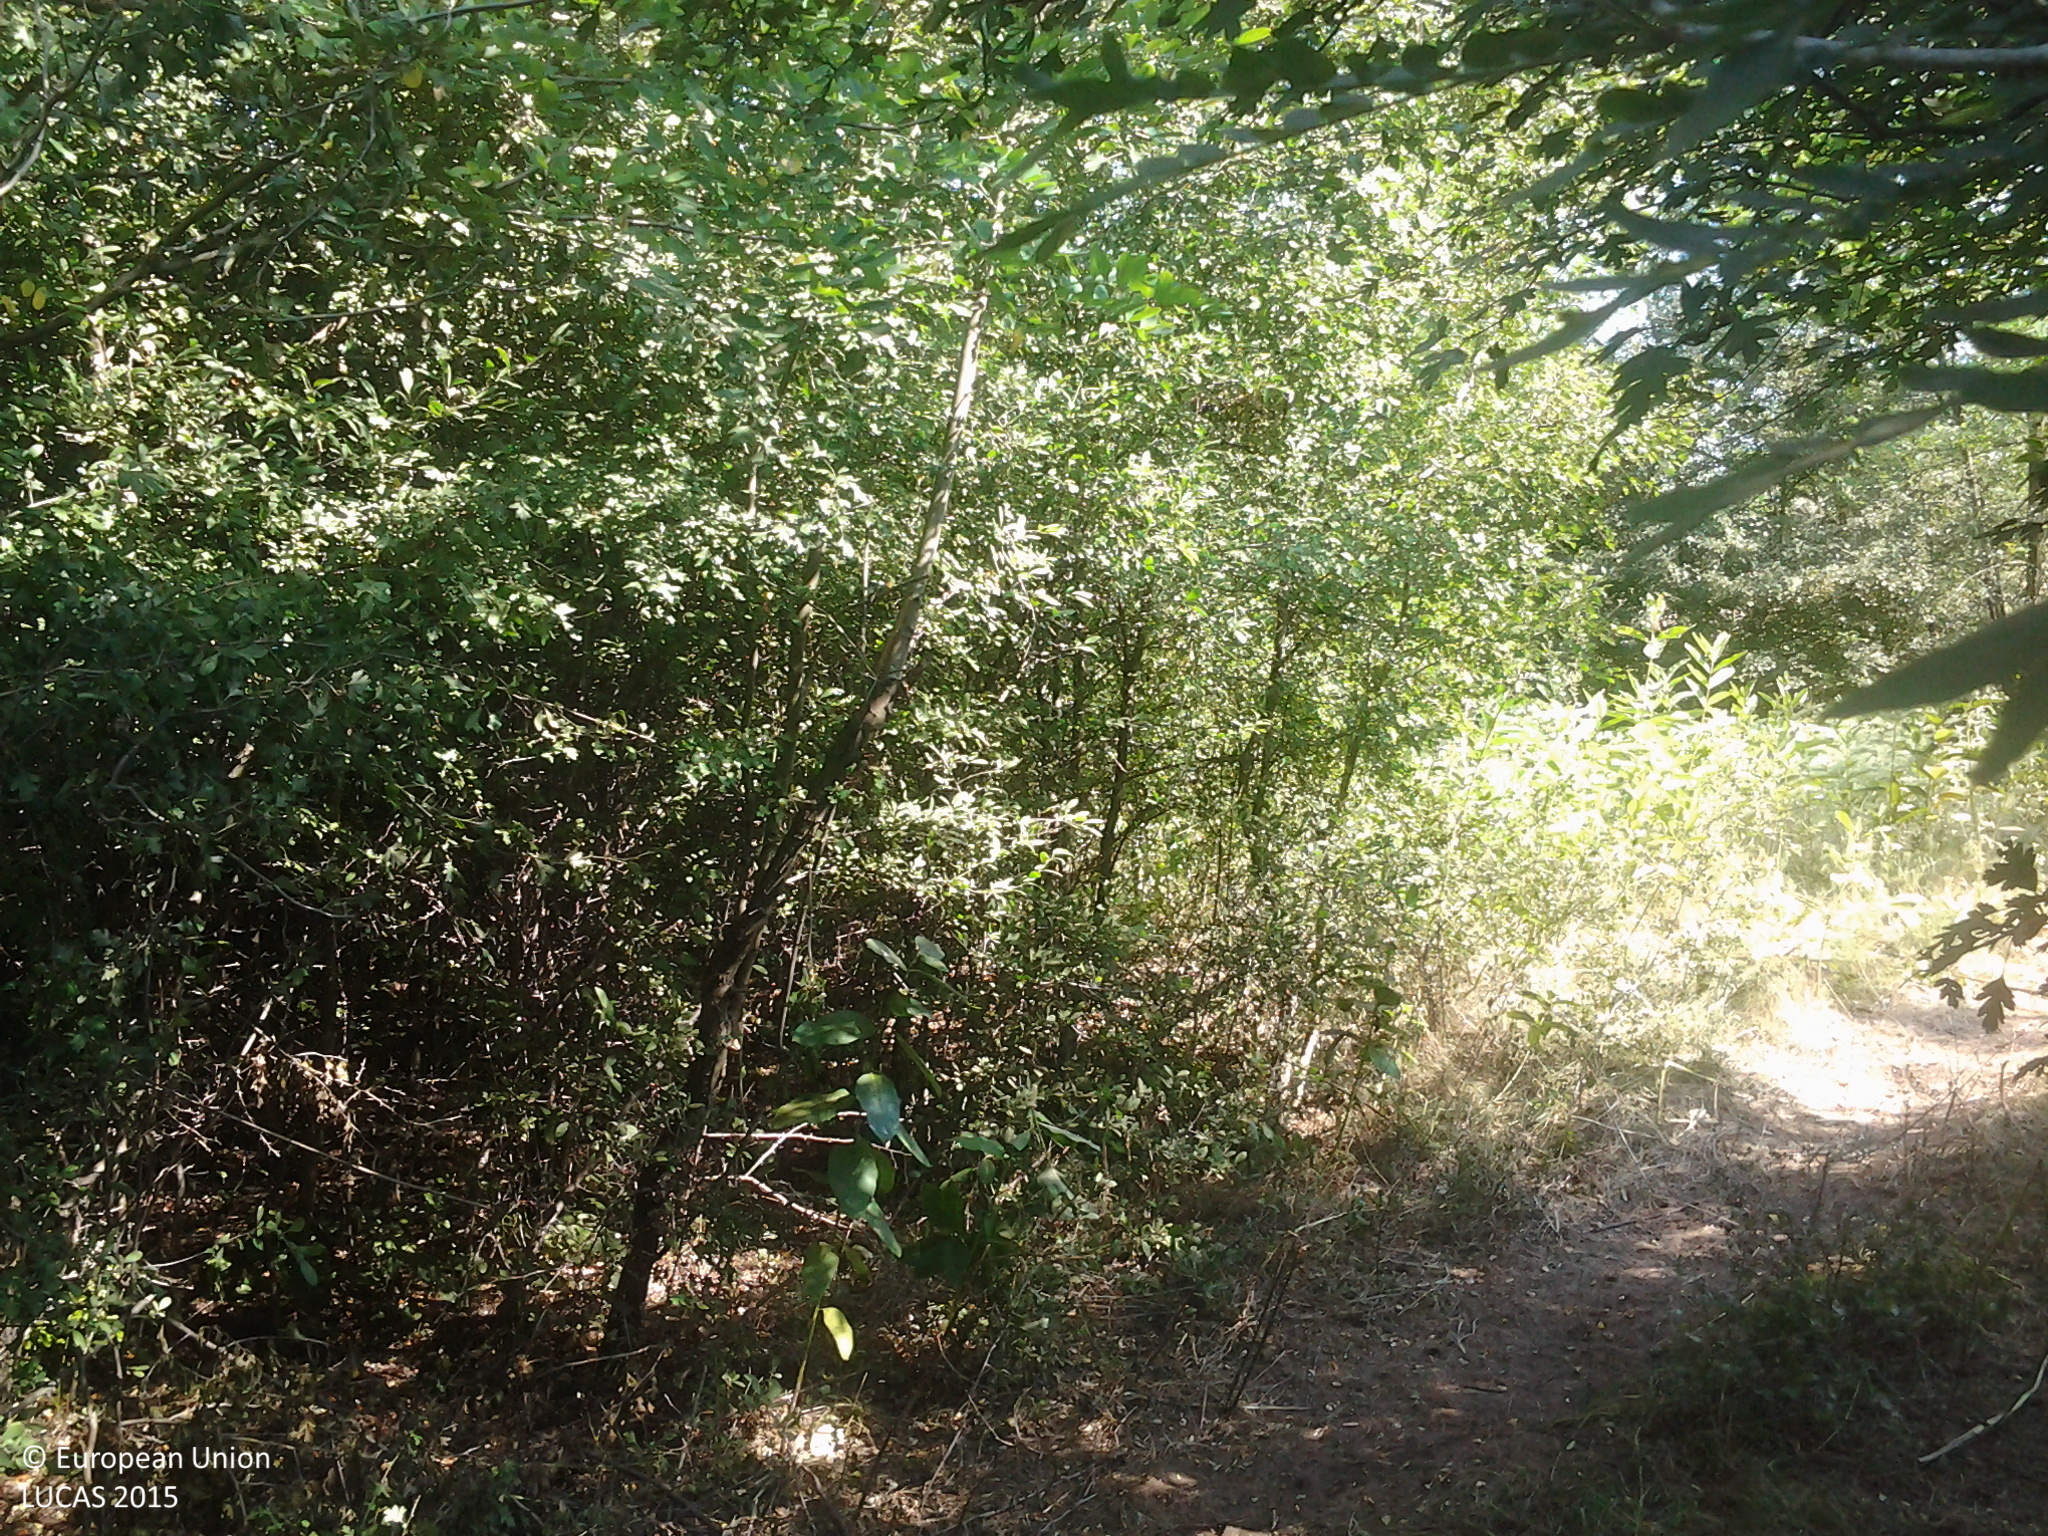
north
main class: Woodland
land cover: Broadleaved woodland
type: mesophytic deciduous forest
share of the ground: > 75 %
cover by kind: broadleaved forest trees 75 %, herbaceous plants 25 %
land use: Forestry
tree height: > 5 m
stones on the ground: < 10 %
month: July
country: HU
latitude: 46.4775
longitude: 19.2238
